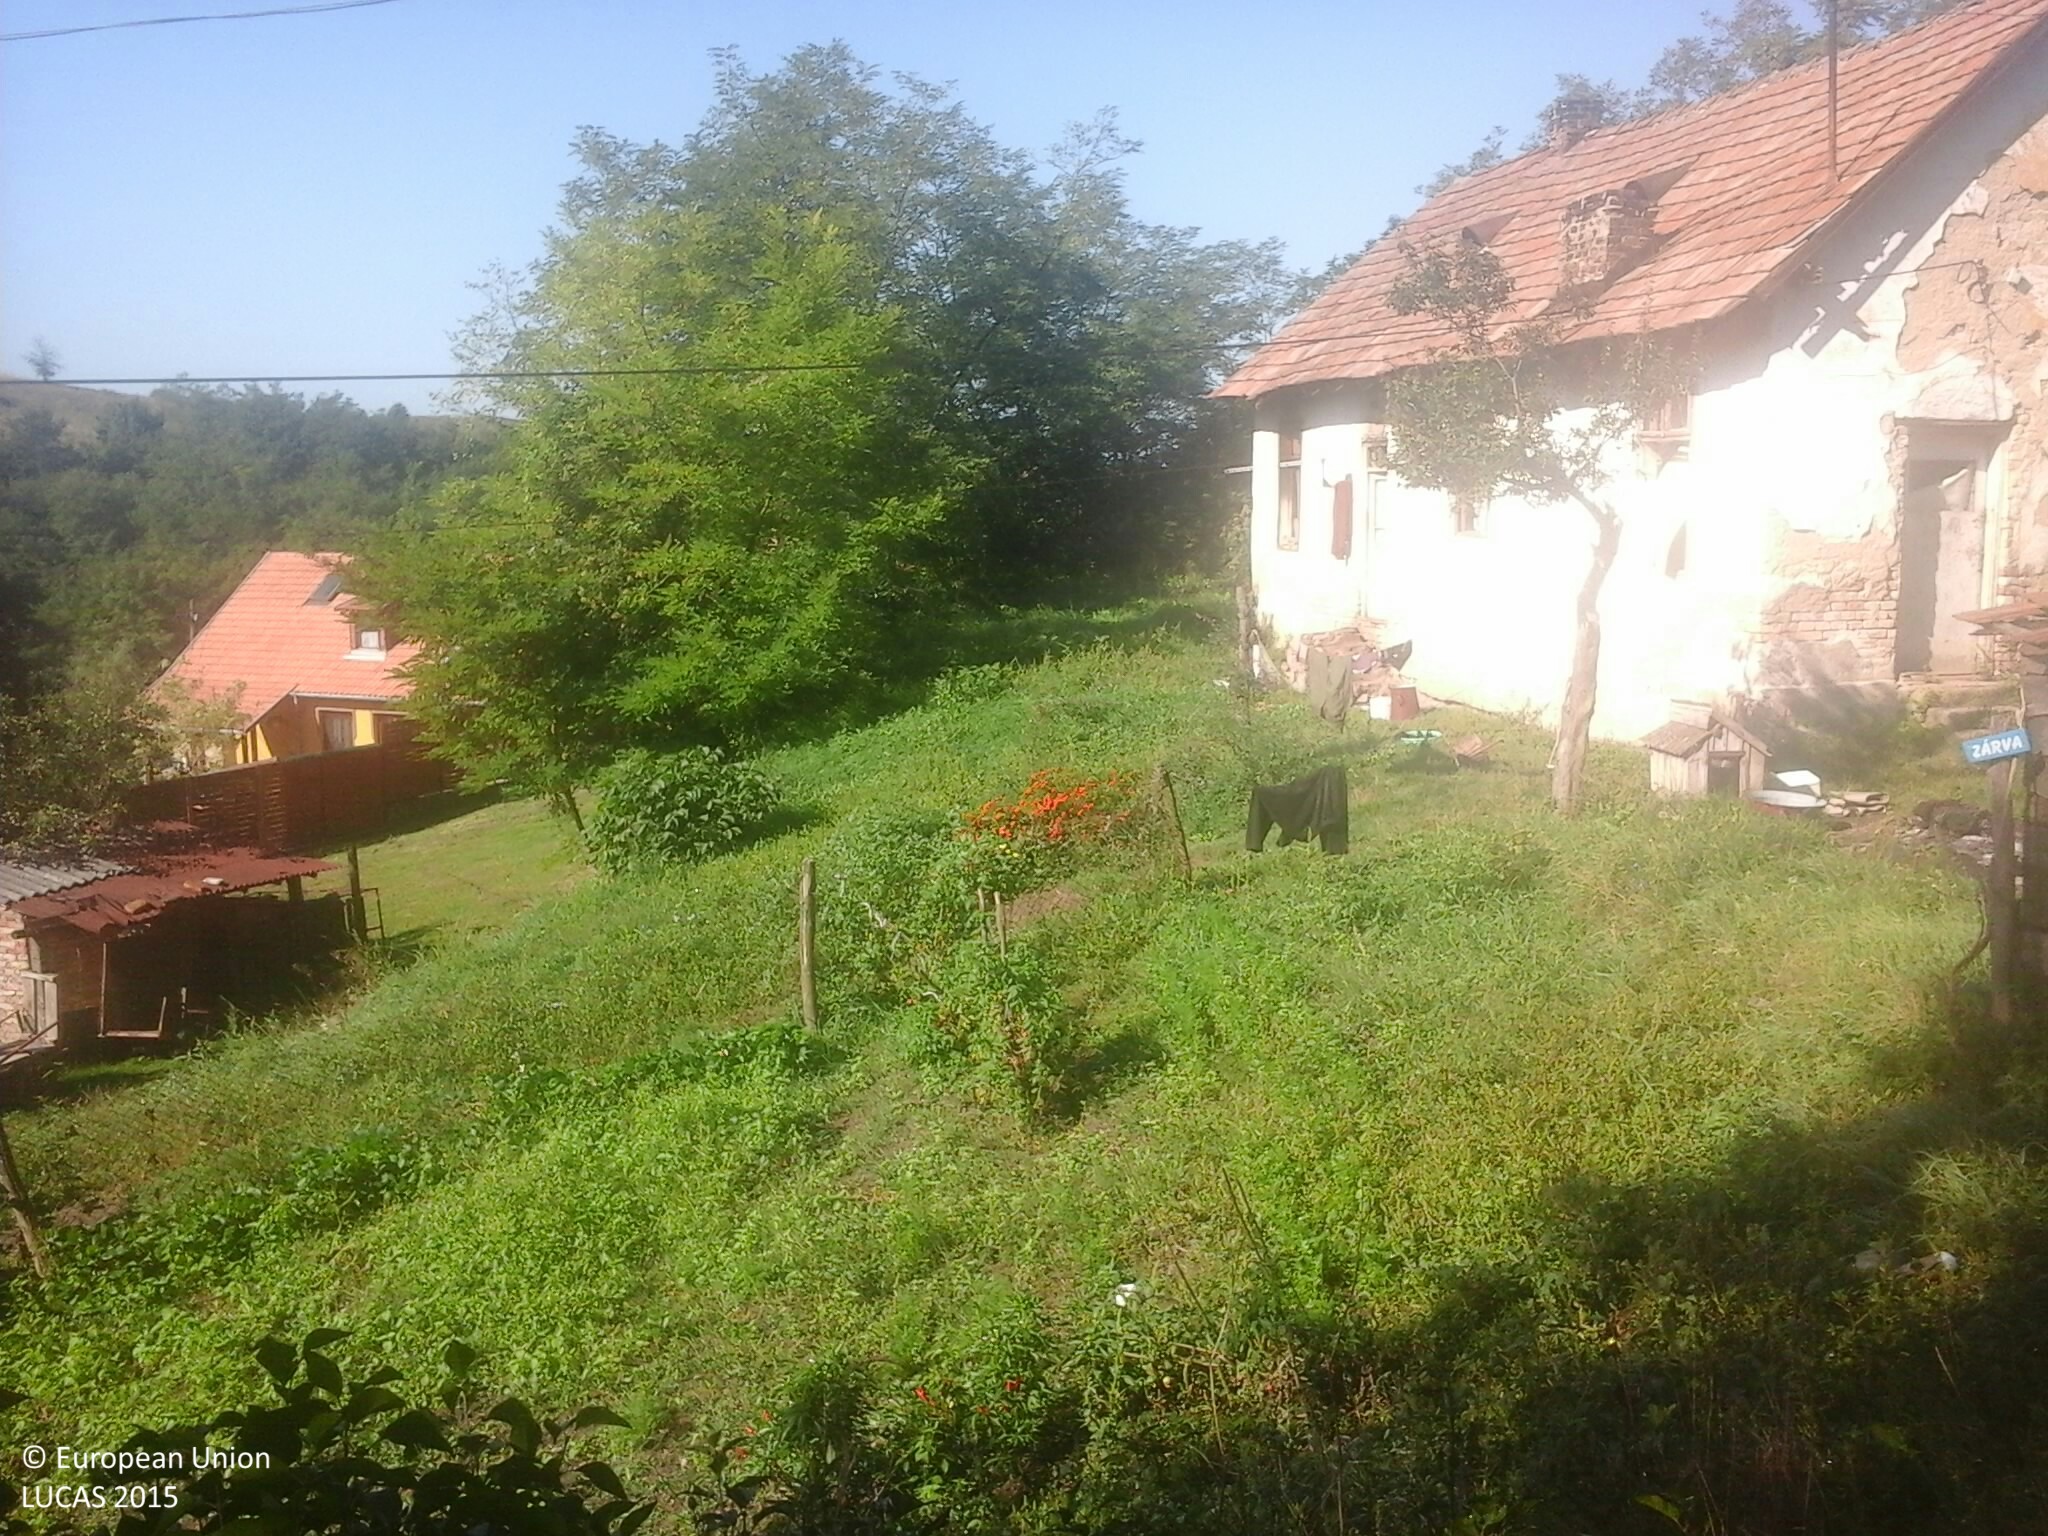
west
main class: Shrubland
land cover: Shrubland with sparse tree cover
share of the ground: > 75 %
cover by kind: shrubs 90 %, broadleaved forest trees 5 %, herbaceous plants 5 %
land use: Fallow land
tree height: > 5 m
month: September
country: HU
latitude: 48.0403
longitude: 19.9939
